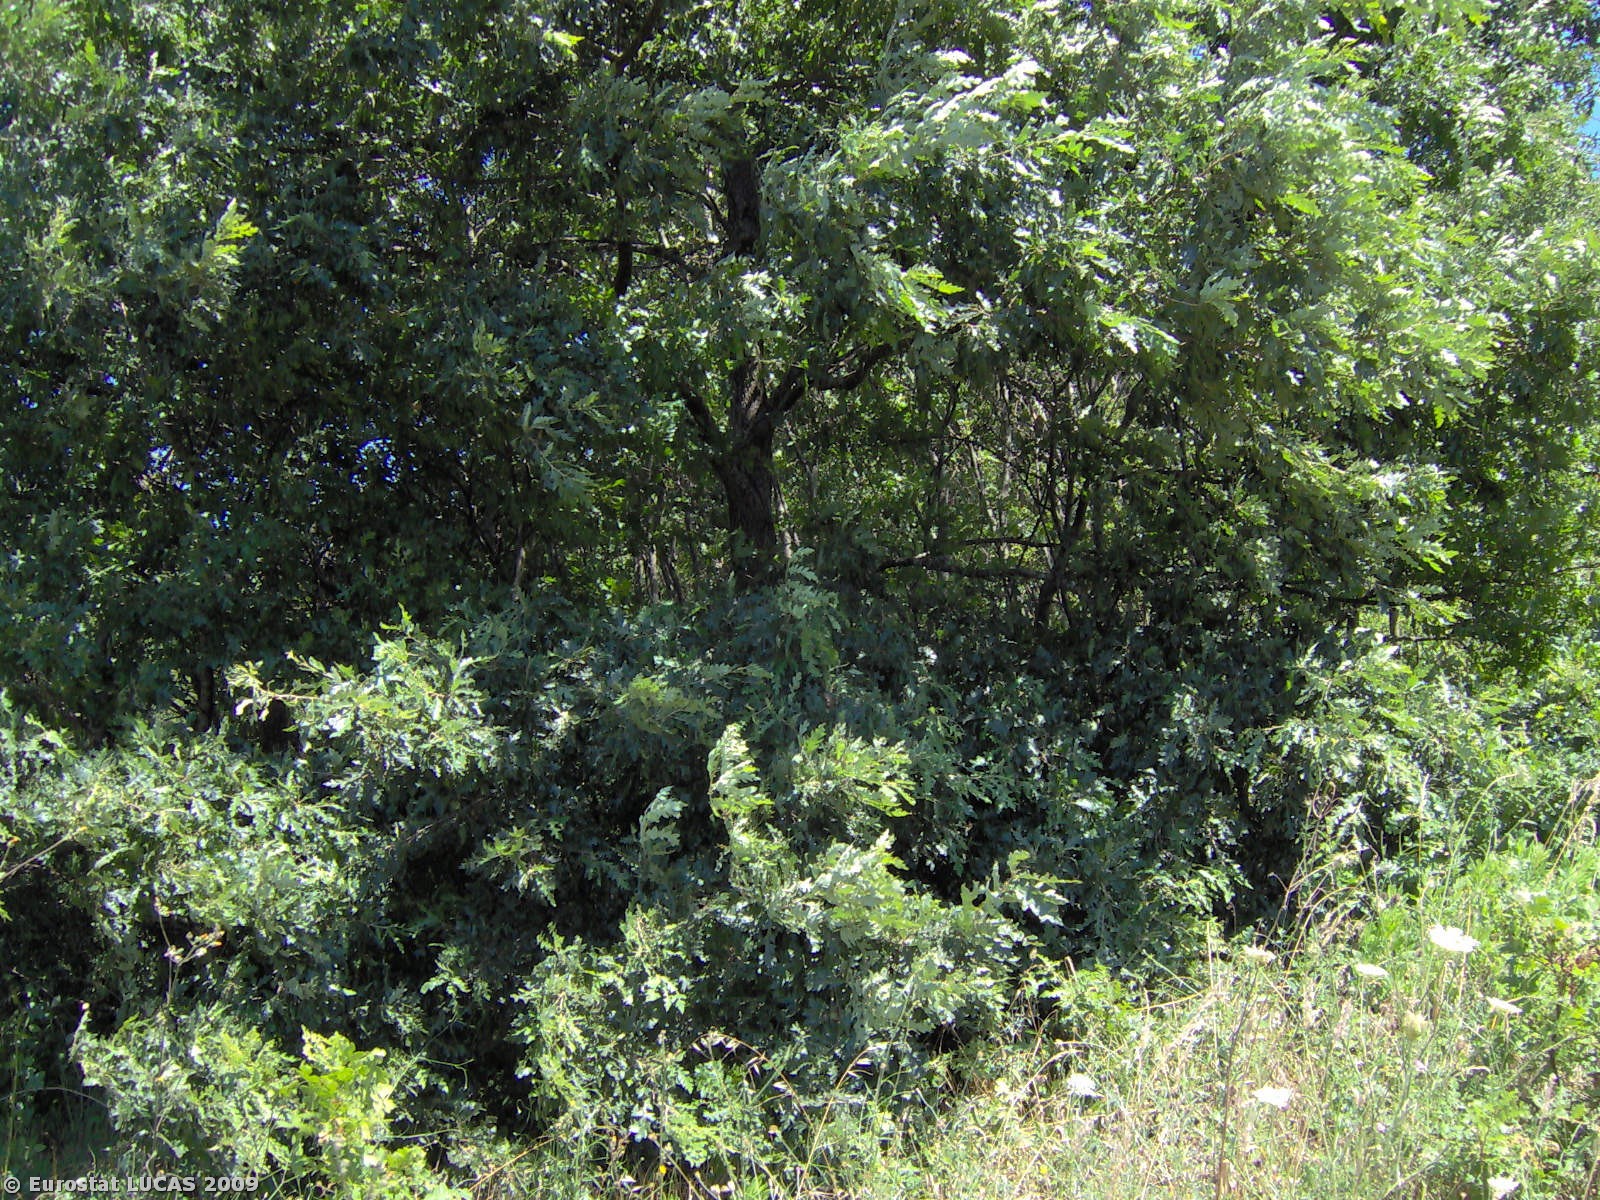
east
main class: Grassland
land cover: Spontaneously vegetated surfaces
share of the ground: > 75 %
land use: Fallow land
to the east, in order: Spontaneously vegetated surfaces; Broadleaved woodland; Electric lines; Broadleaved woodland; Electric lines; Grass margins; Paved roads, cycling and walking lanes; Grass margins; Mixed cereals for fodder; Grass margins; Paved roads, cycling and walking lanes; Grass margins; Broadleaved woodland; Mixed cereals for fodder
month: July
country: IT
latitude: 40.6904
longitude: 15.5518
